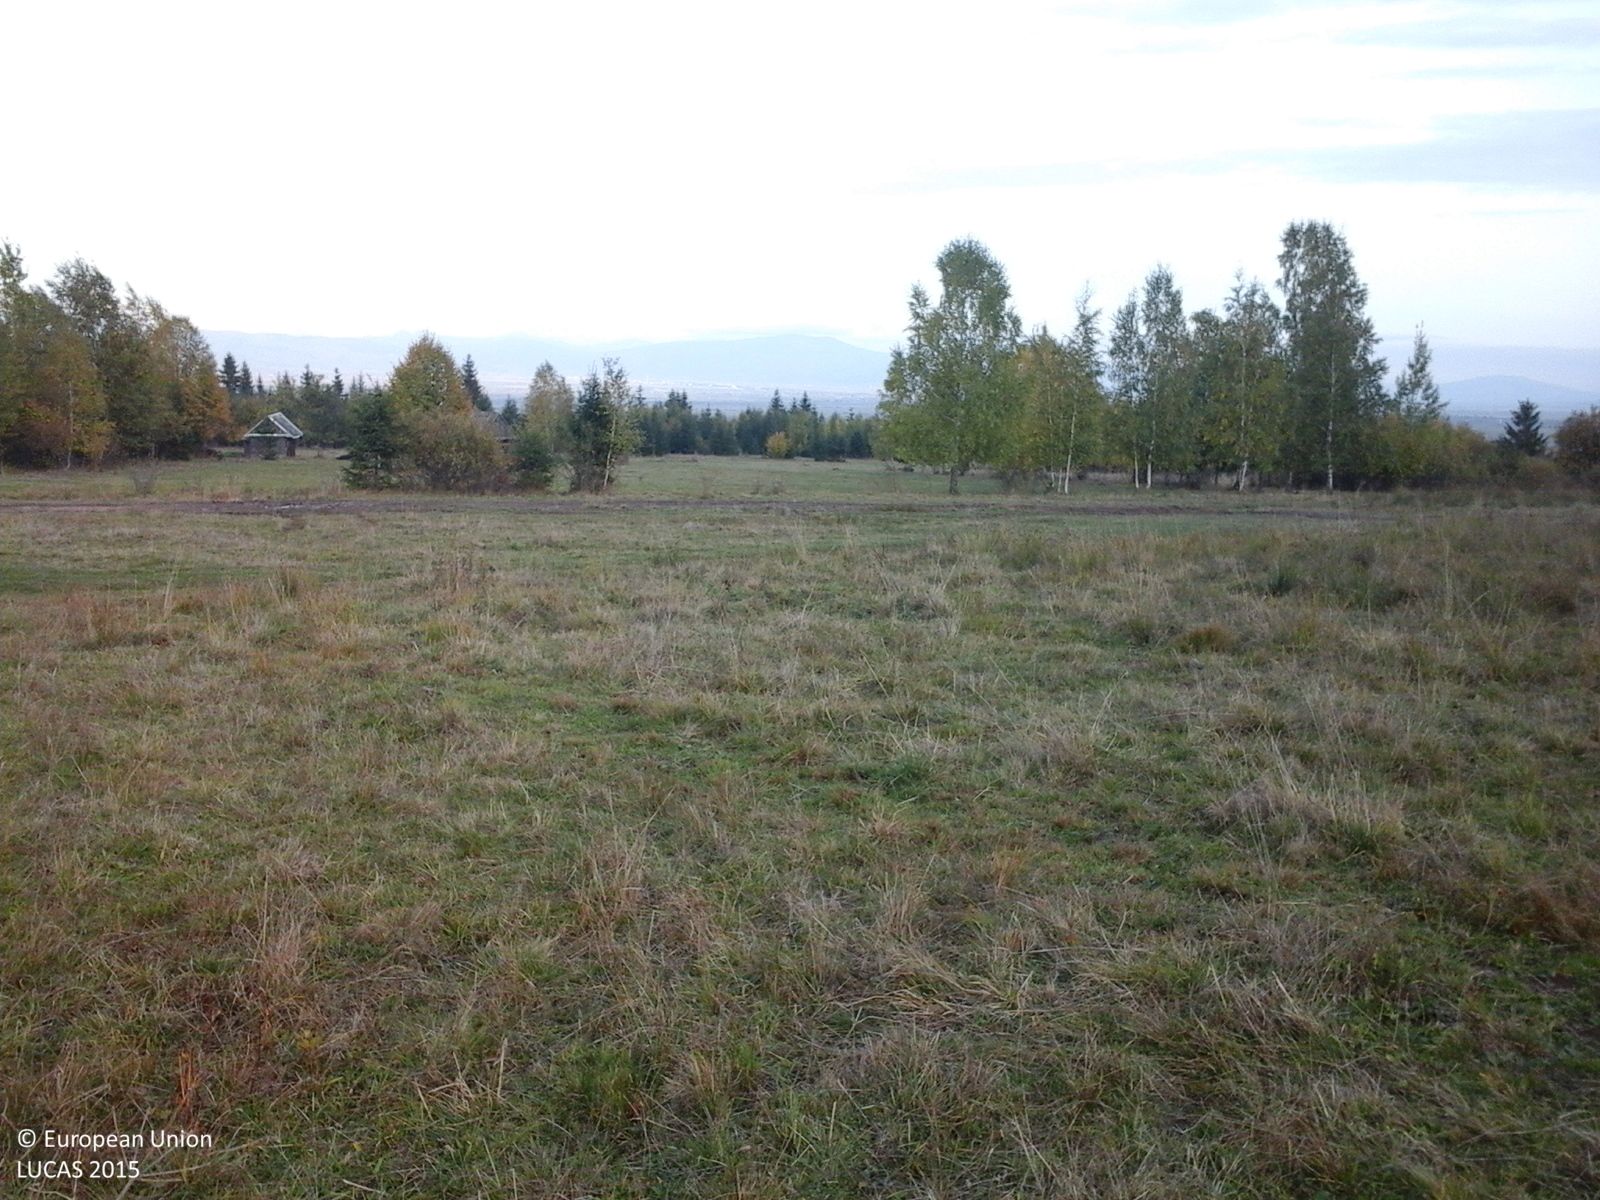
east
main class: Grassland
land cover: Grassland without tree/shrub cover
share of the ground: > 75 %
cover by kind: herbaceous plants 100 %
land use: Agriculture (excluding fallow land and kitchen gardens)
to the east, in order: Grassland without tree/shrub cover; Tracks; Grassland without tree/shrub cover; Tracks; Grass margins; Lines of trees; Grassland without tree/shrub cover; Spruce dominated coniferous woodland
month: October
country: RO
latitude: 46.7154
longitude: 25.3741
